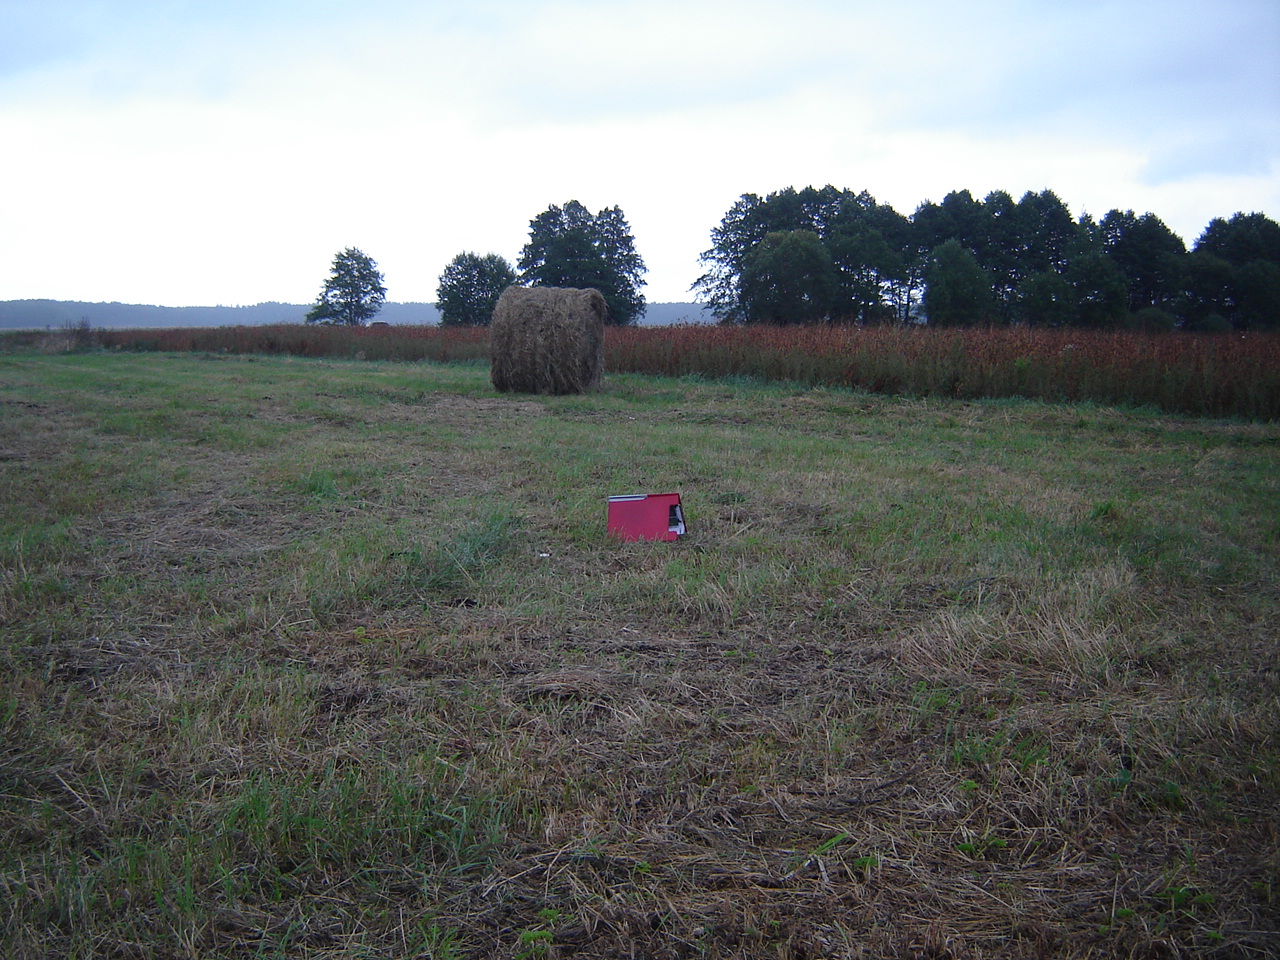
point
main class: Grassland
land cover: Grassland without tree/shrub cover
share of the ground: > 75 %
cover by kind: herbaceous plants 100 %
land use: Agriculture (excluding fallow land and kitchen gardens)
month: September
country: LT
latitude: 54.3868
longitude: 24.8165
